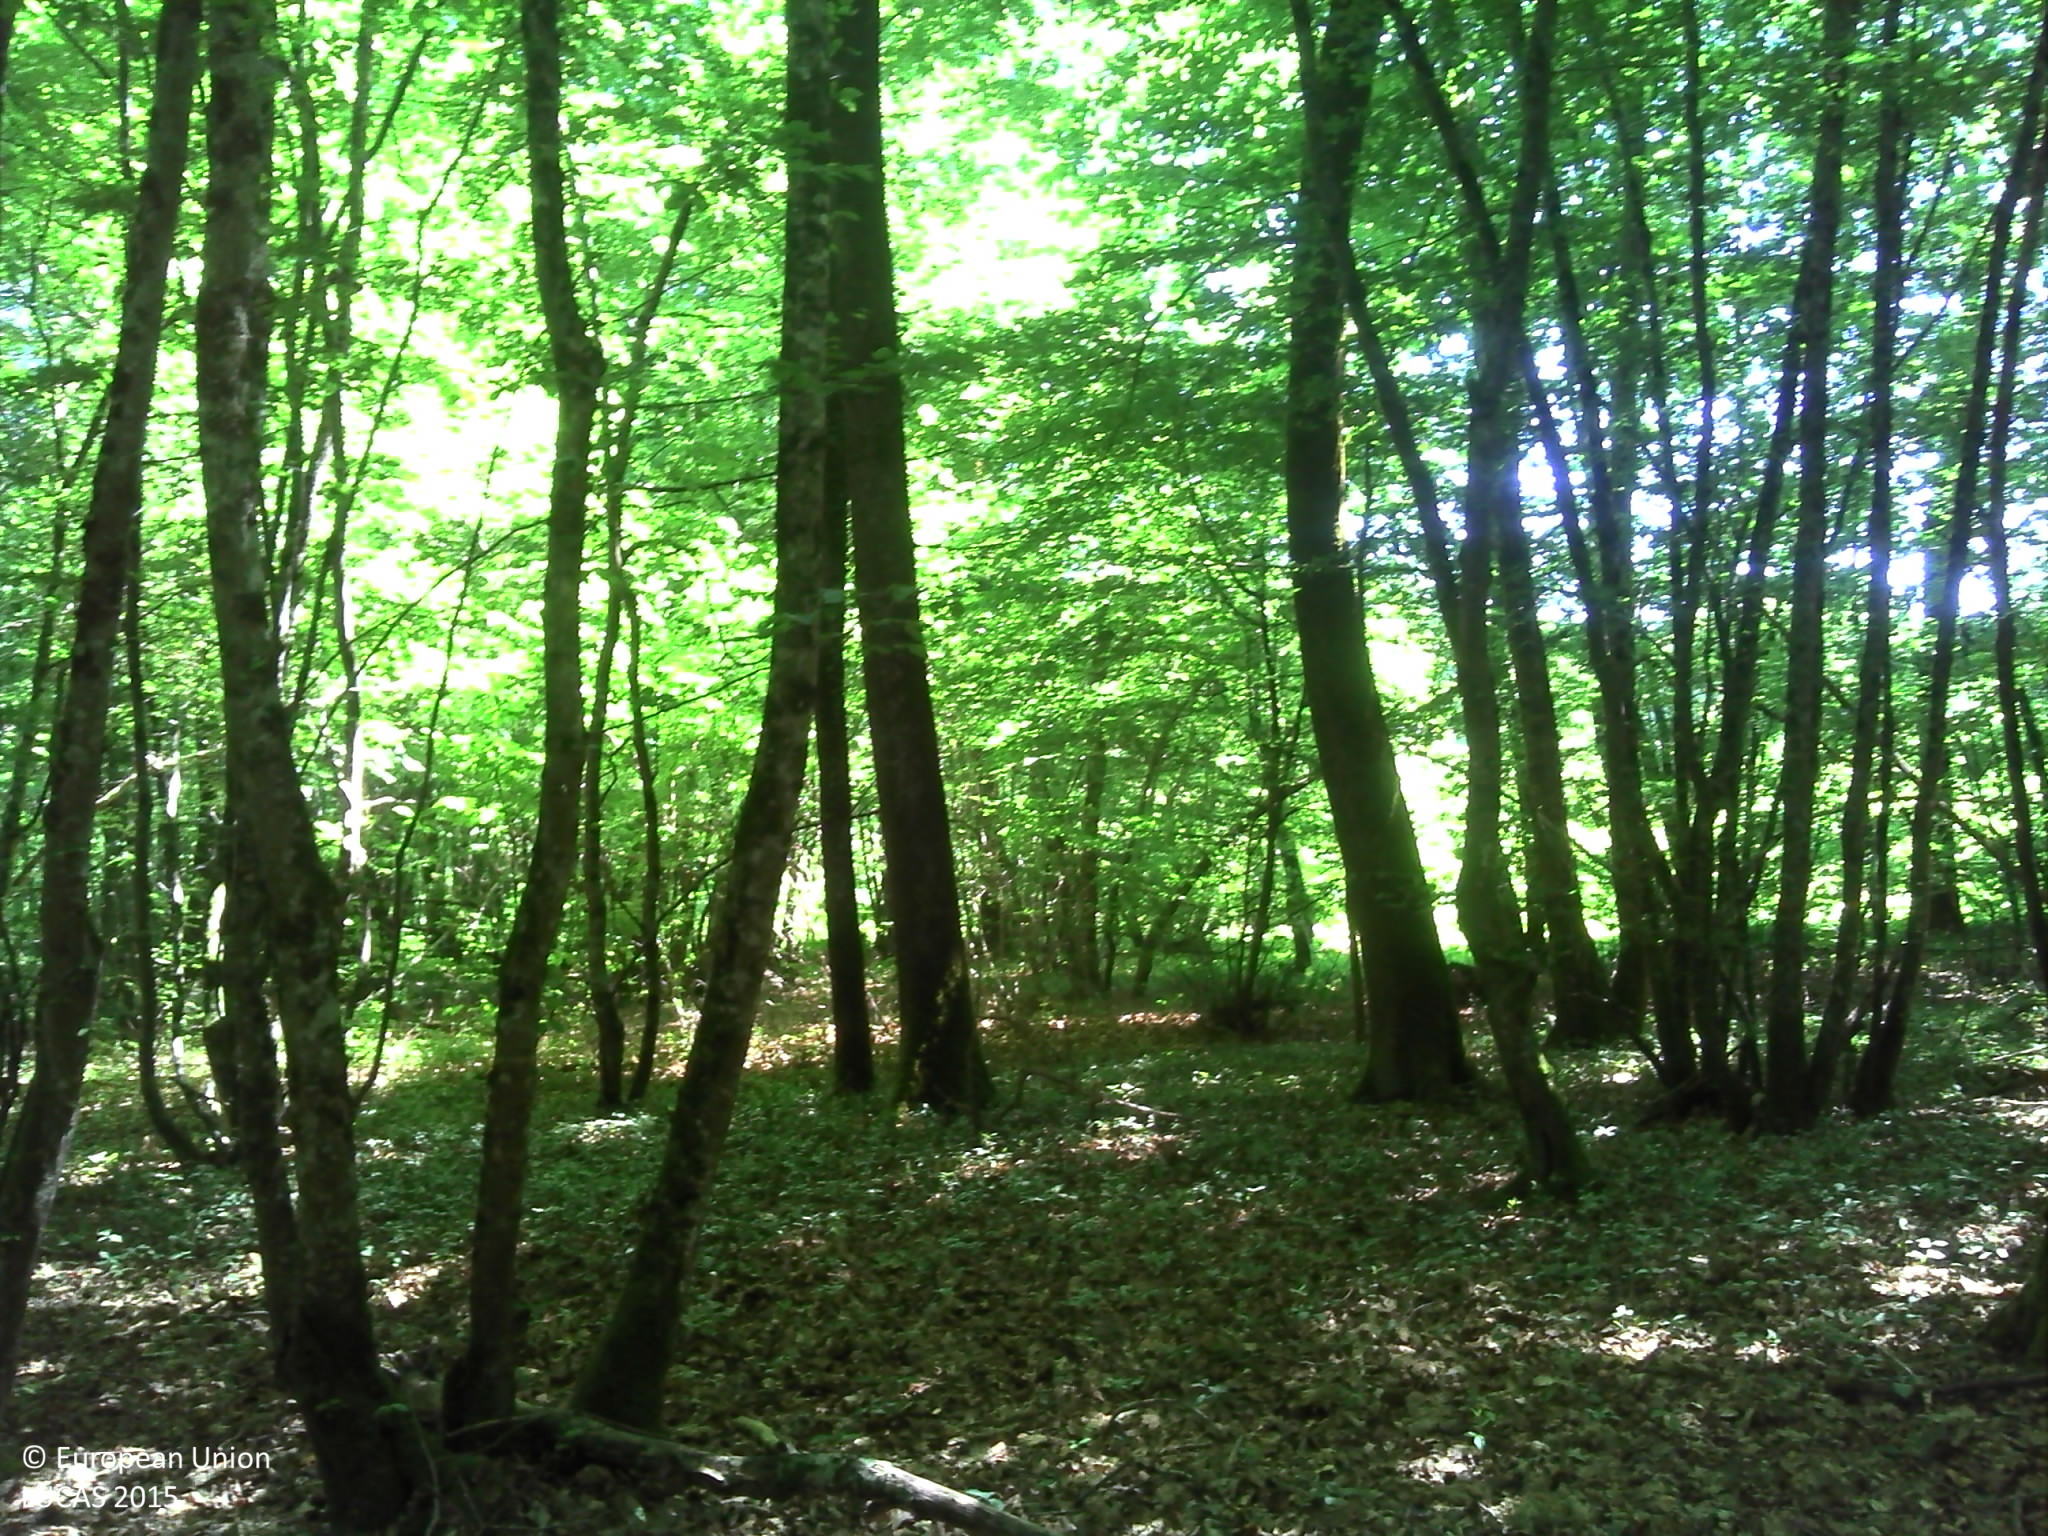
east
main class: Woodland
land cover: Broadleaved woodland
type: mesophytic deciduous forest
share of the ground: > 75 %
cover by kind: broadleaved forest trees 90 %, unconsolidated bare surface 10 %
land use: Forestry
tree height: > 5 m
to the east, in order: Broadleaved woodland; Tracks; Broadleaved woodland; Maize
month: June
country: FR
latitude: 47.1305
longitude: 2.6772
